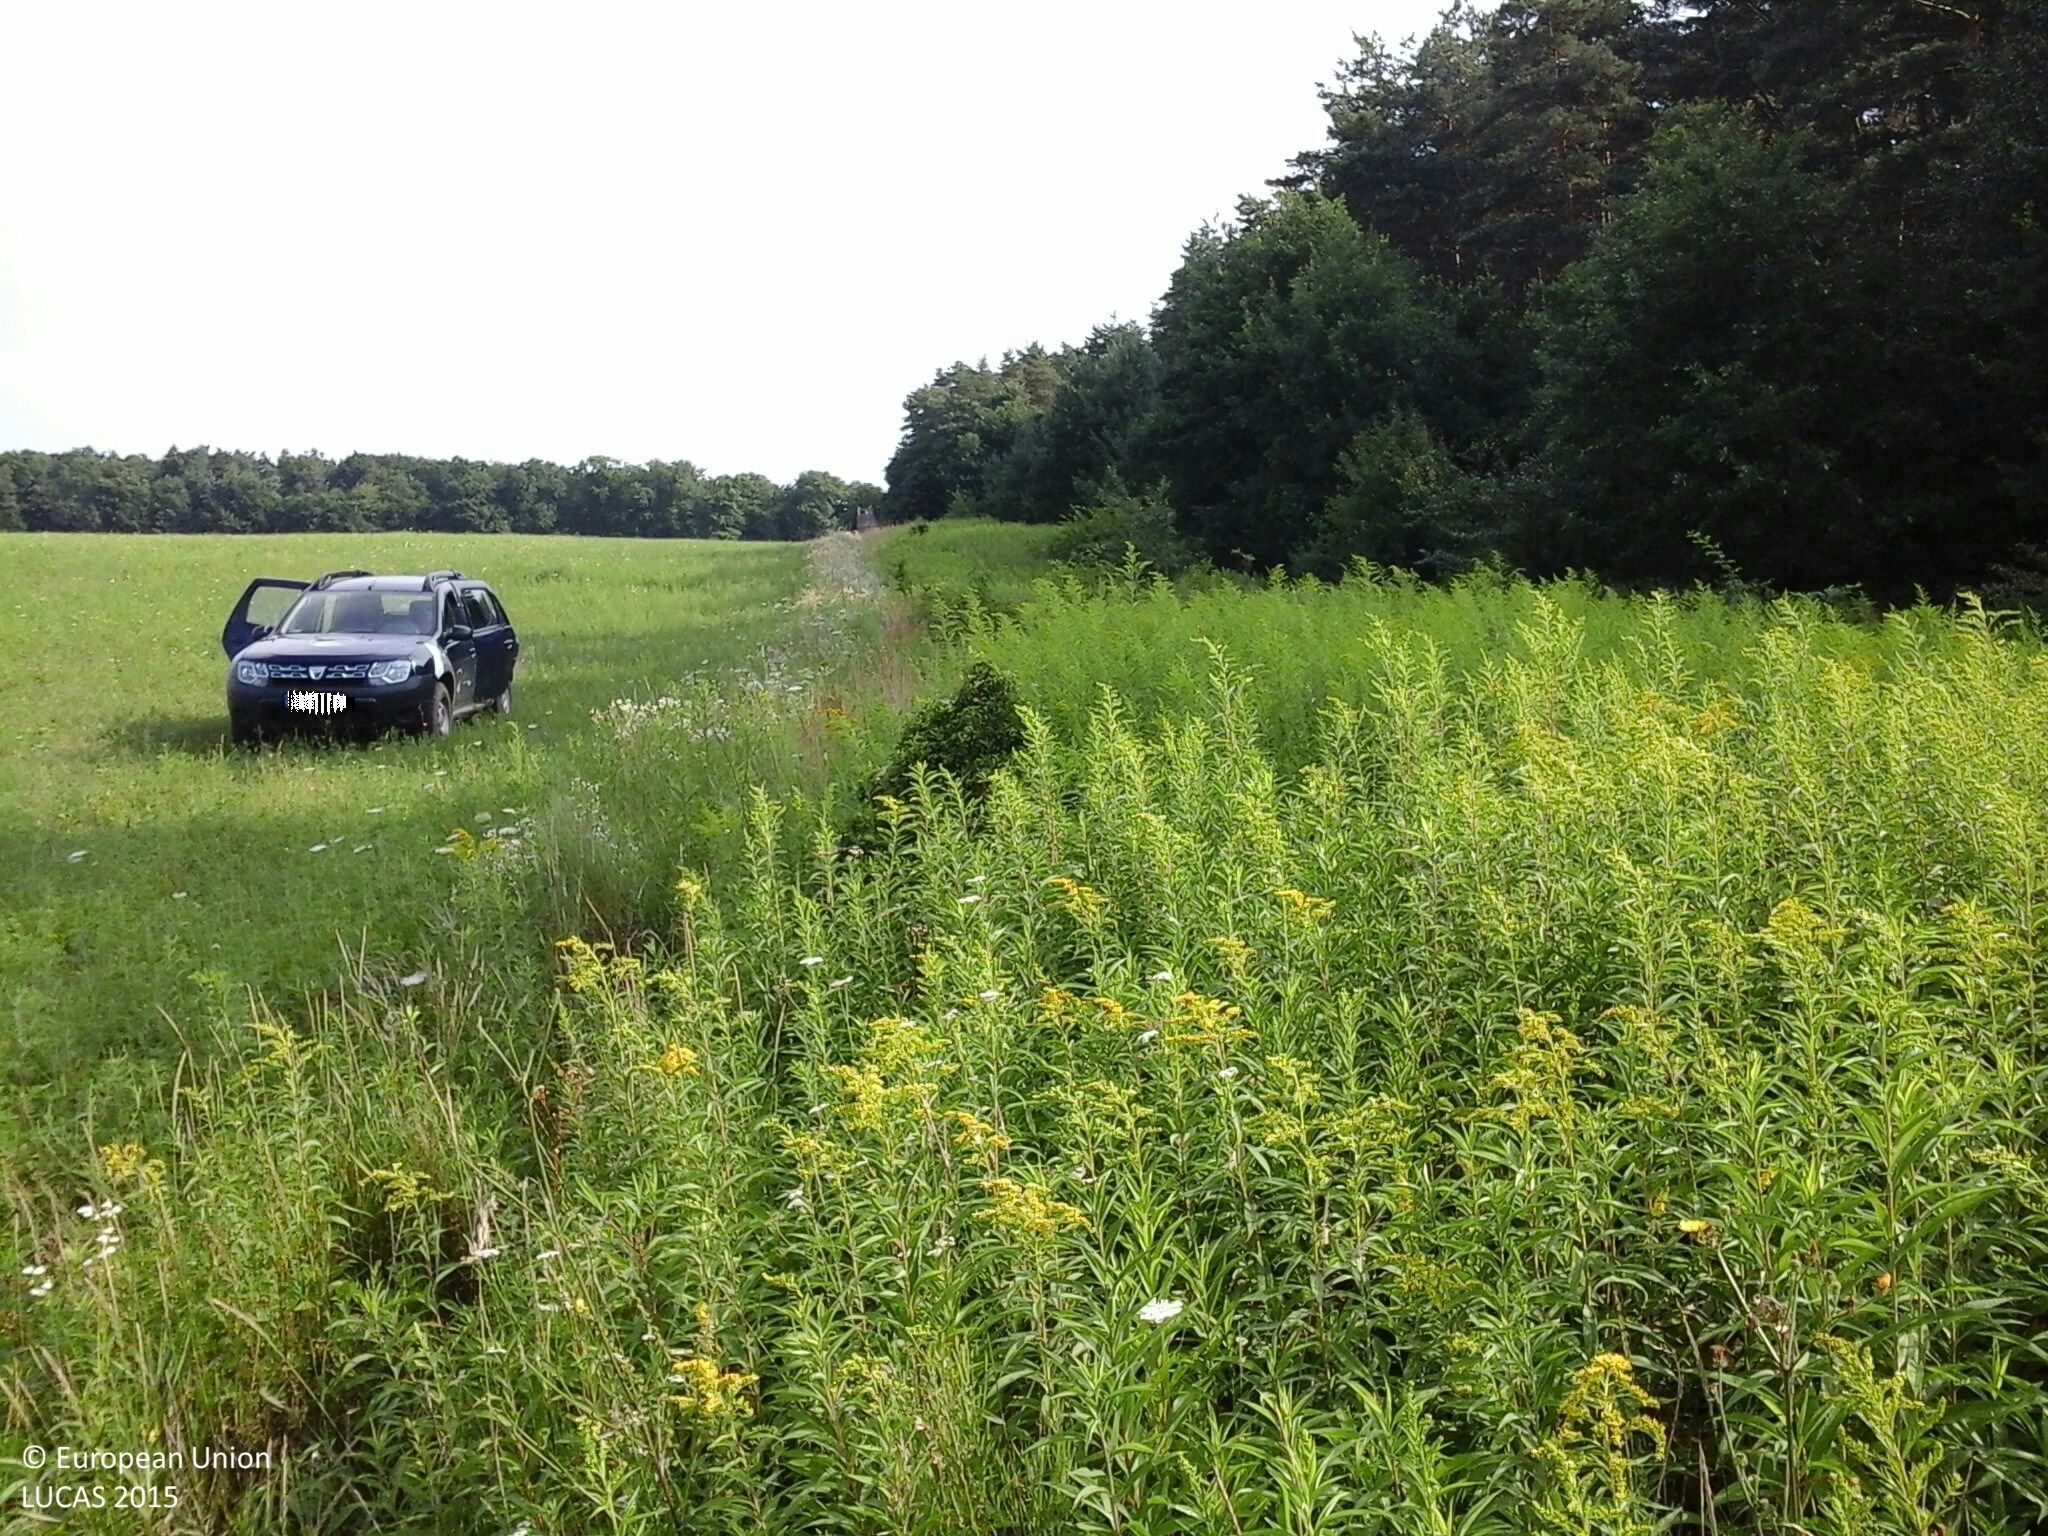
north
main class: Grassland
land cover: Grassland without tree/shrub cover
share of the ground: > 75 %
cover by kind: herbaceous plants 100 %
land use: Abandoned areas
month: July
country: HU
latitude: 46.8435
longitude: 16.4404
